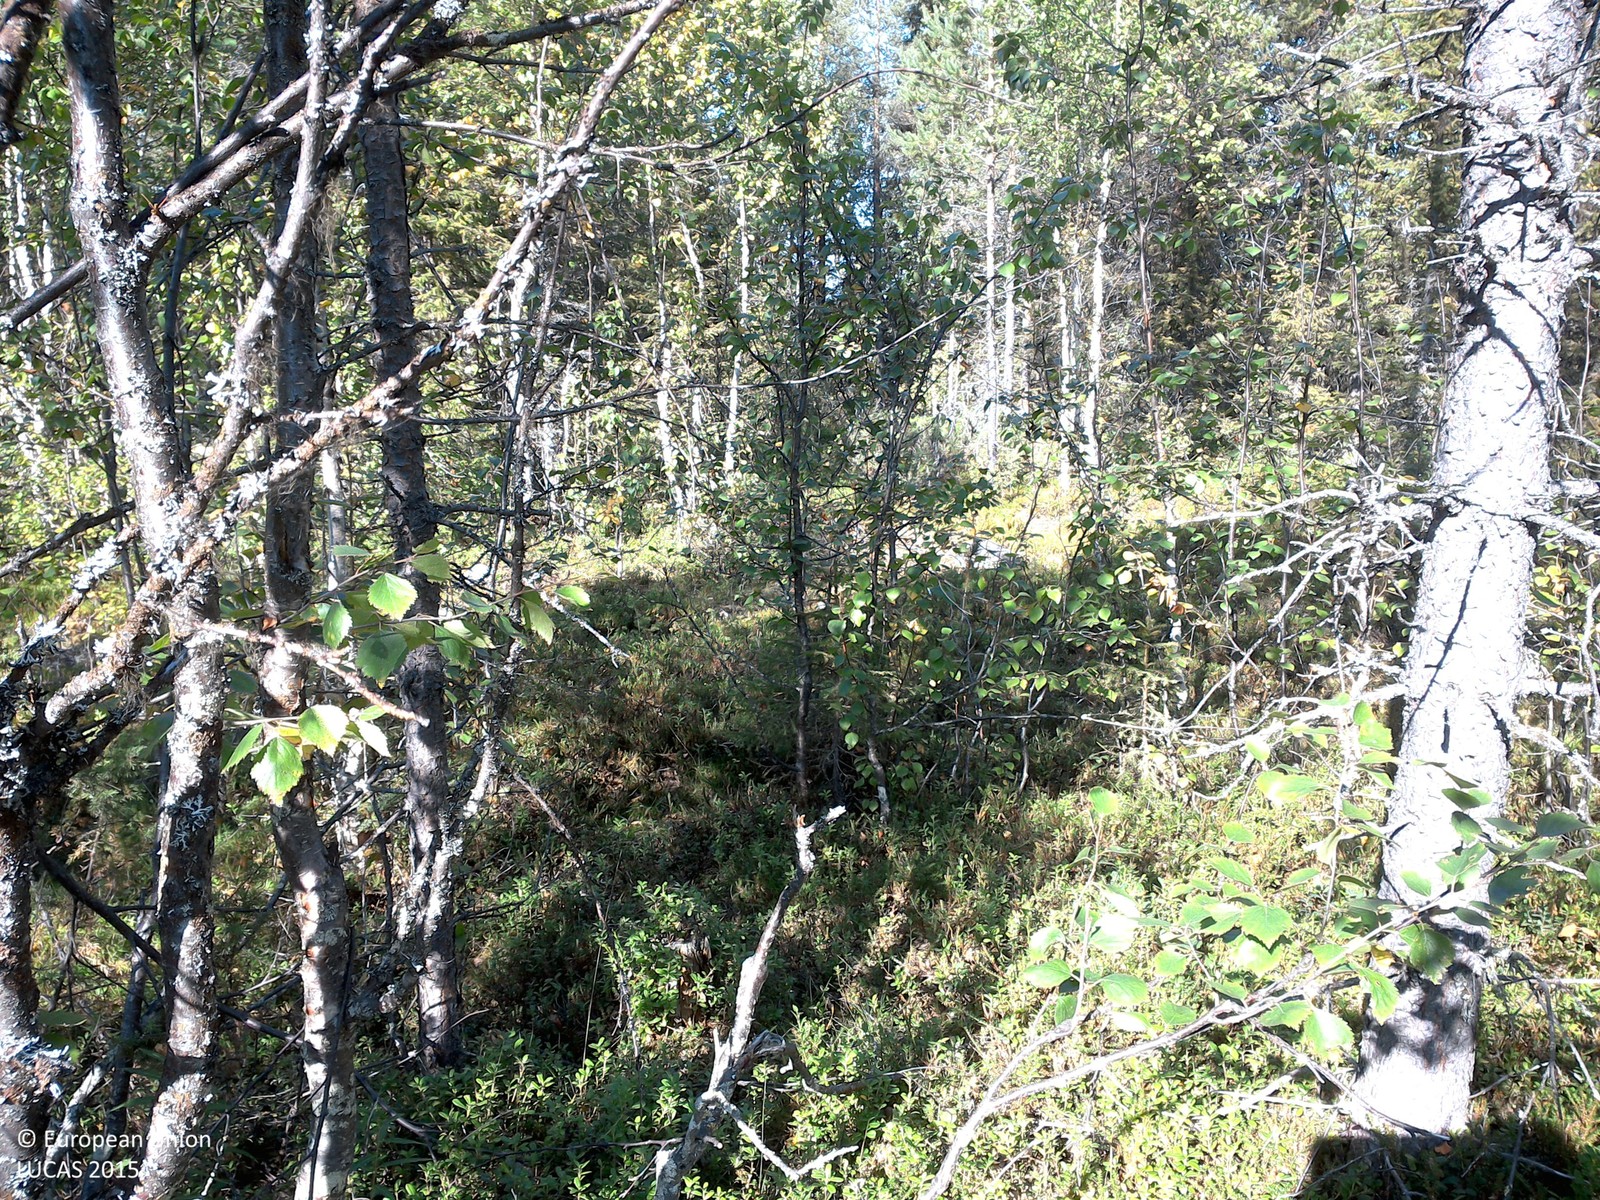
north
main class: Woodland
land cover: Other mixed woodland
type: boreal forest
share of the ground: 25 - 50 %
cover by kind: shrubs 60 %, broadleaved forest trees 25 %, coniferous forest trees 10 %, lichens and mosses 5 %
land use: Forestry
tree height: > 5 m
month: August
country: SE
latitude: 67.3828
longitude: 22.0959
